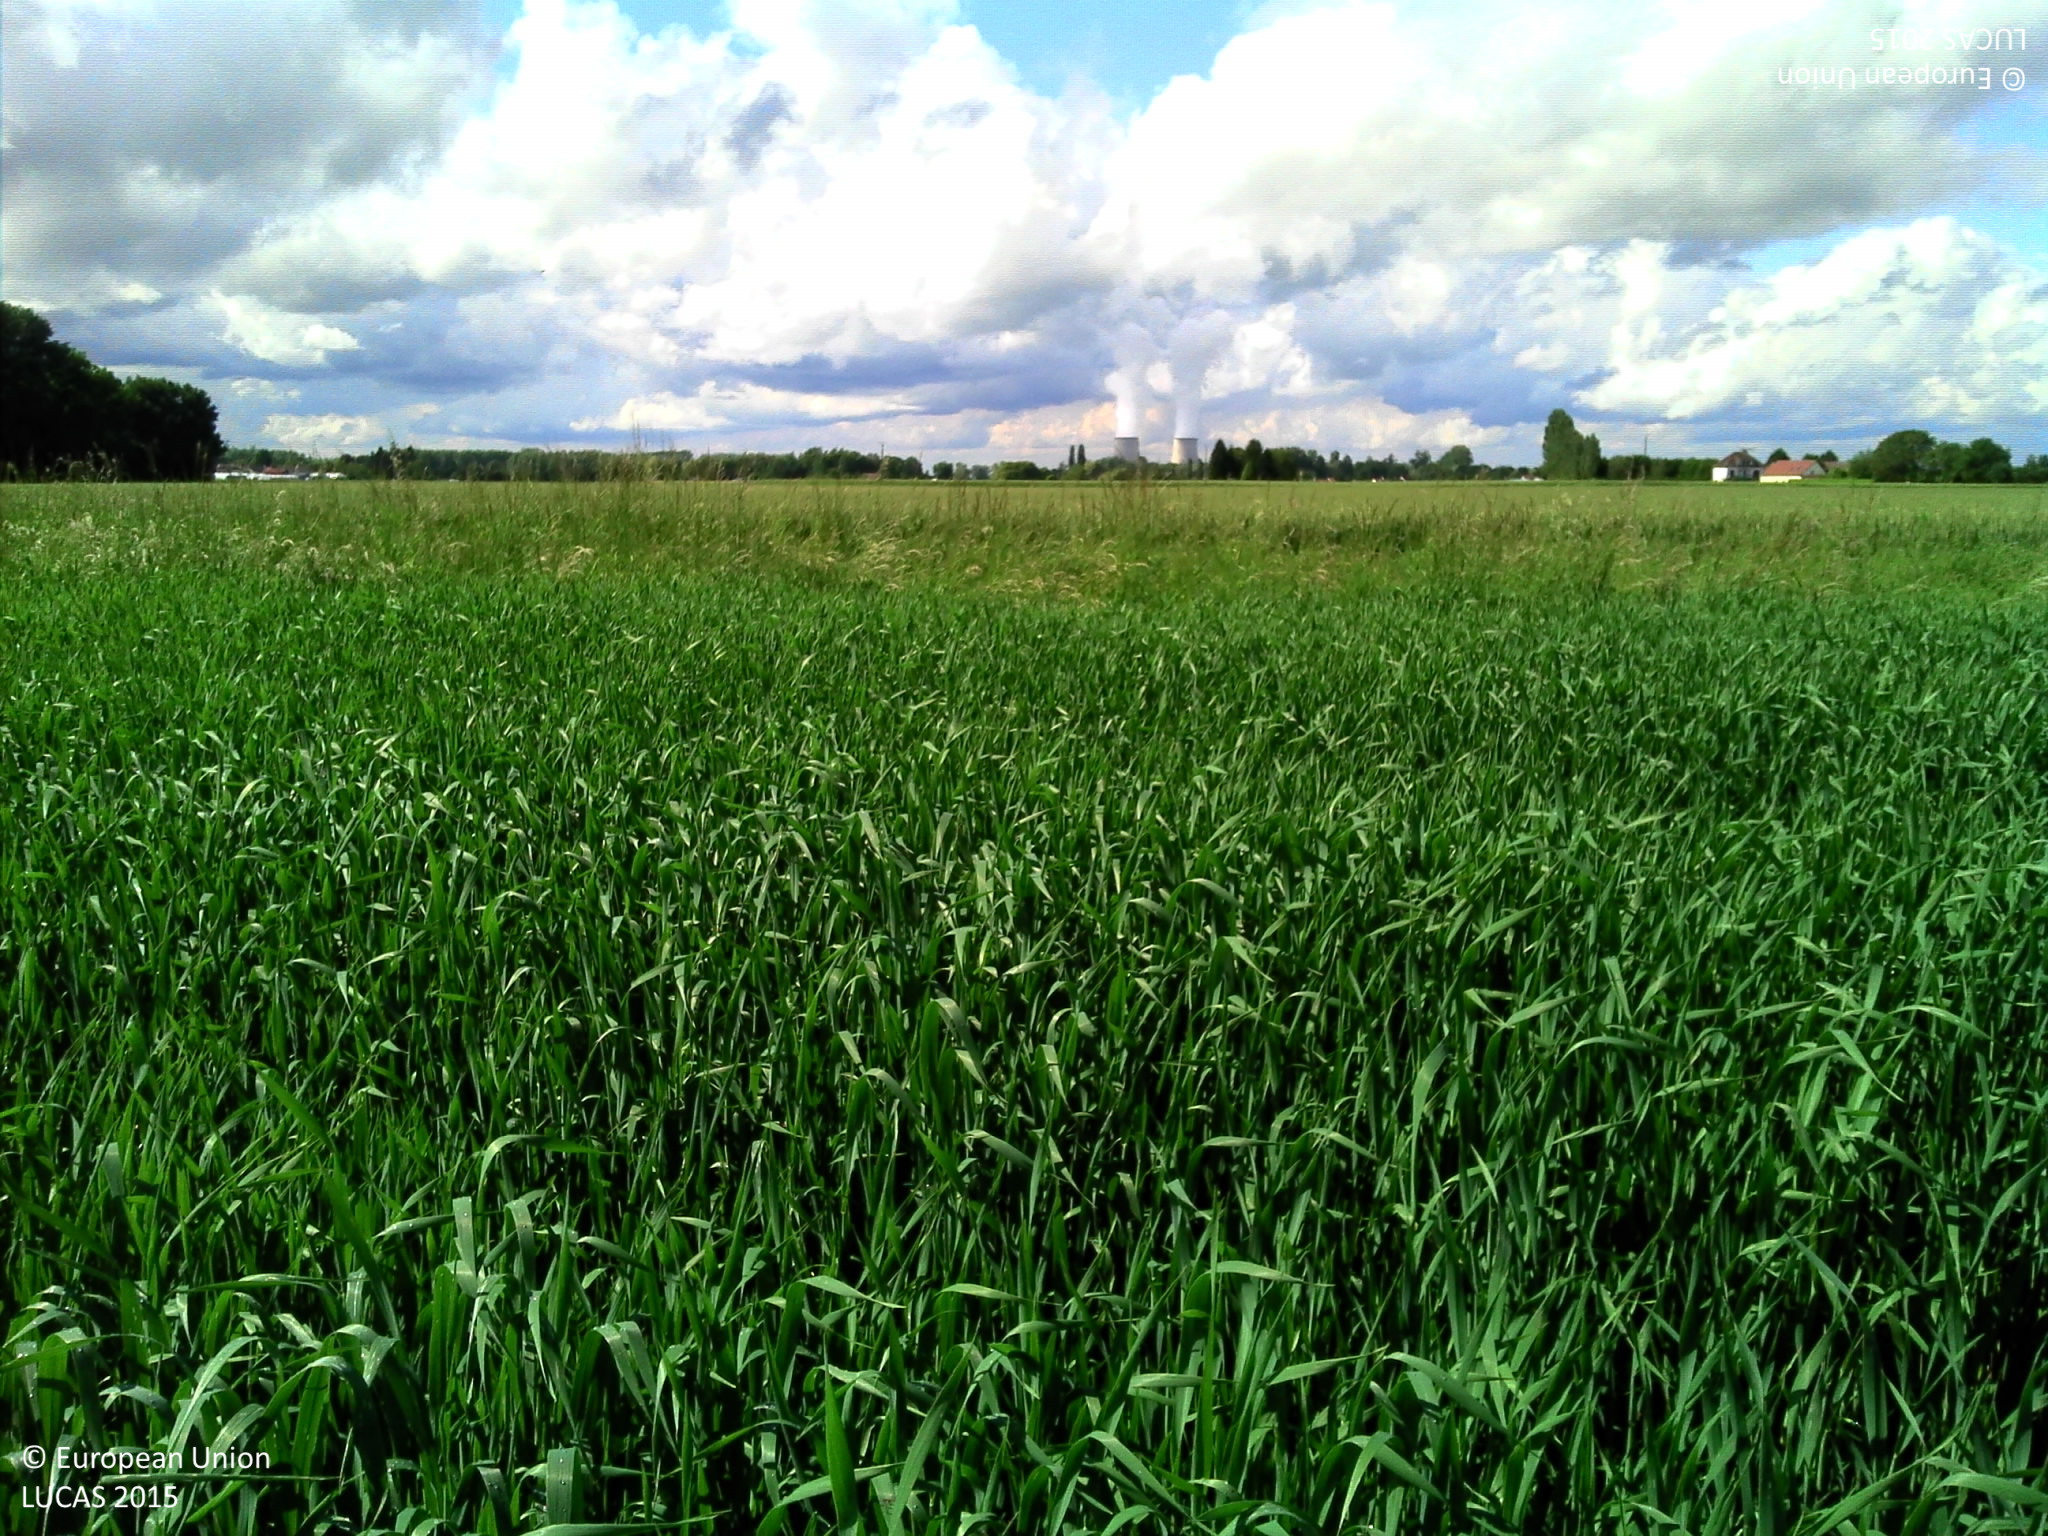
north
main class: Cropland
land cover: Oats
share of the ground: > 75 %
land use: Agriculture (excluding fallow land and kitchen gardens)
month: May
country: FR
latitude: 47.4524
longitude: 2.8981
